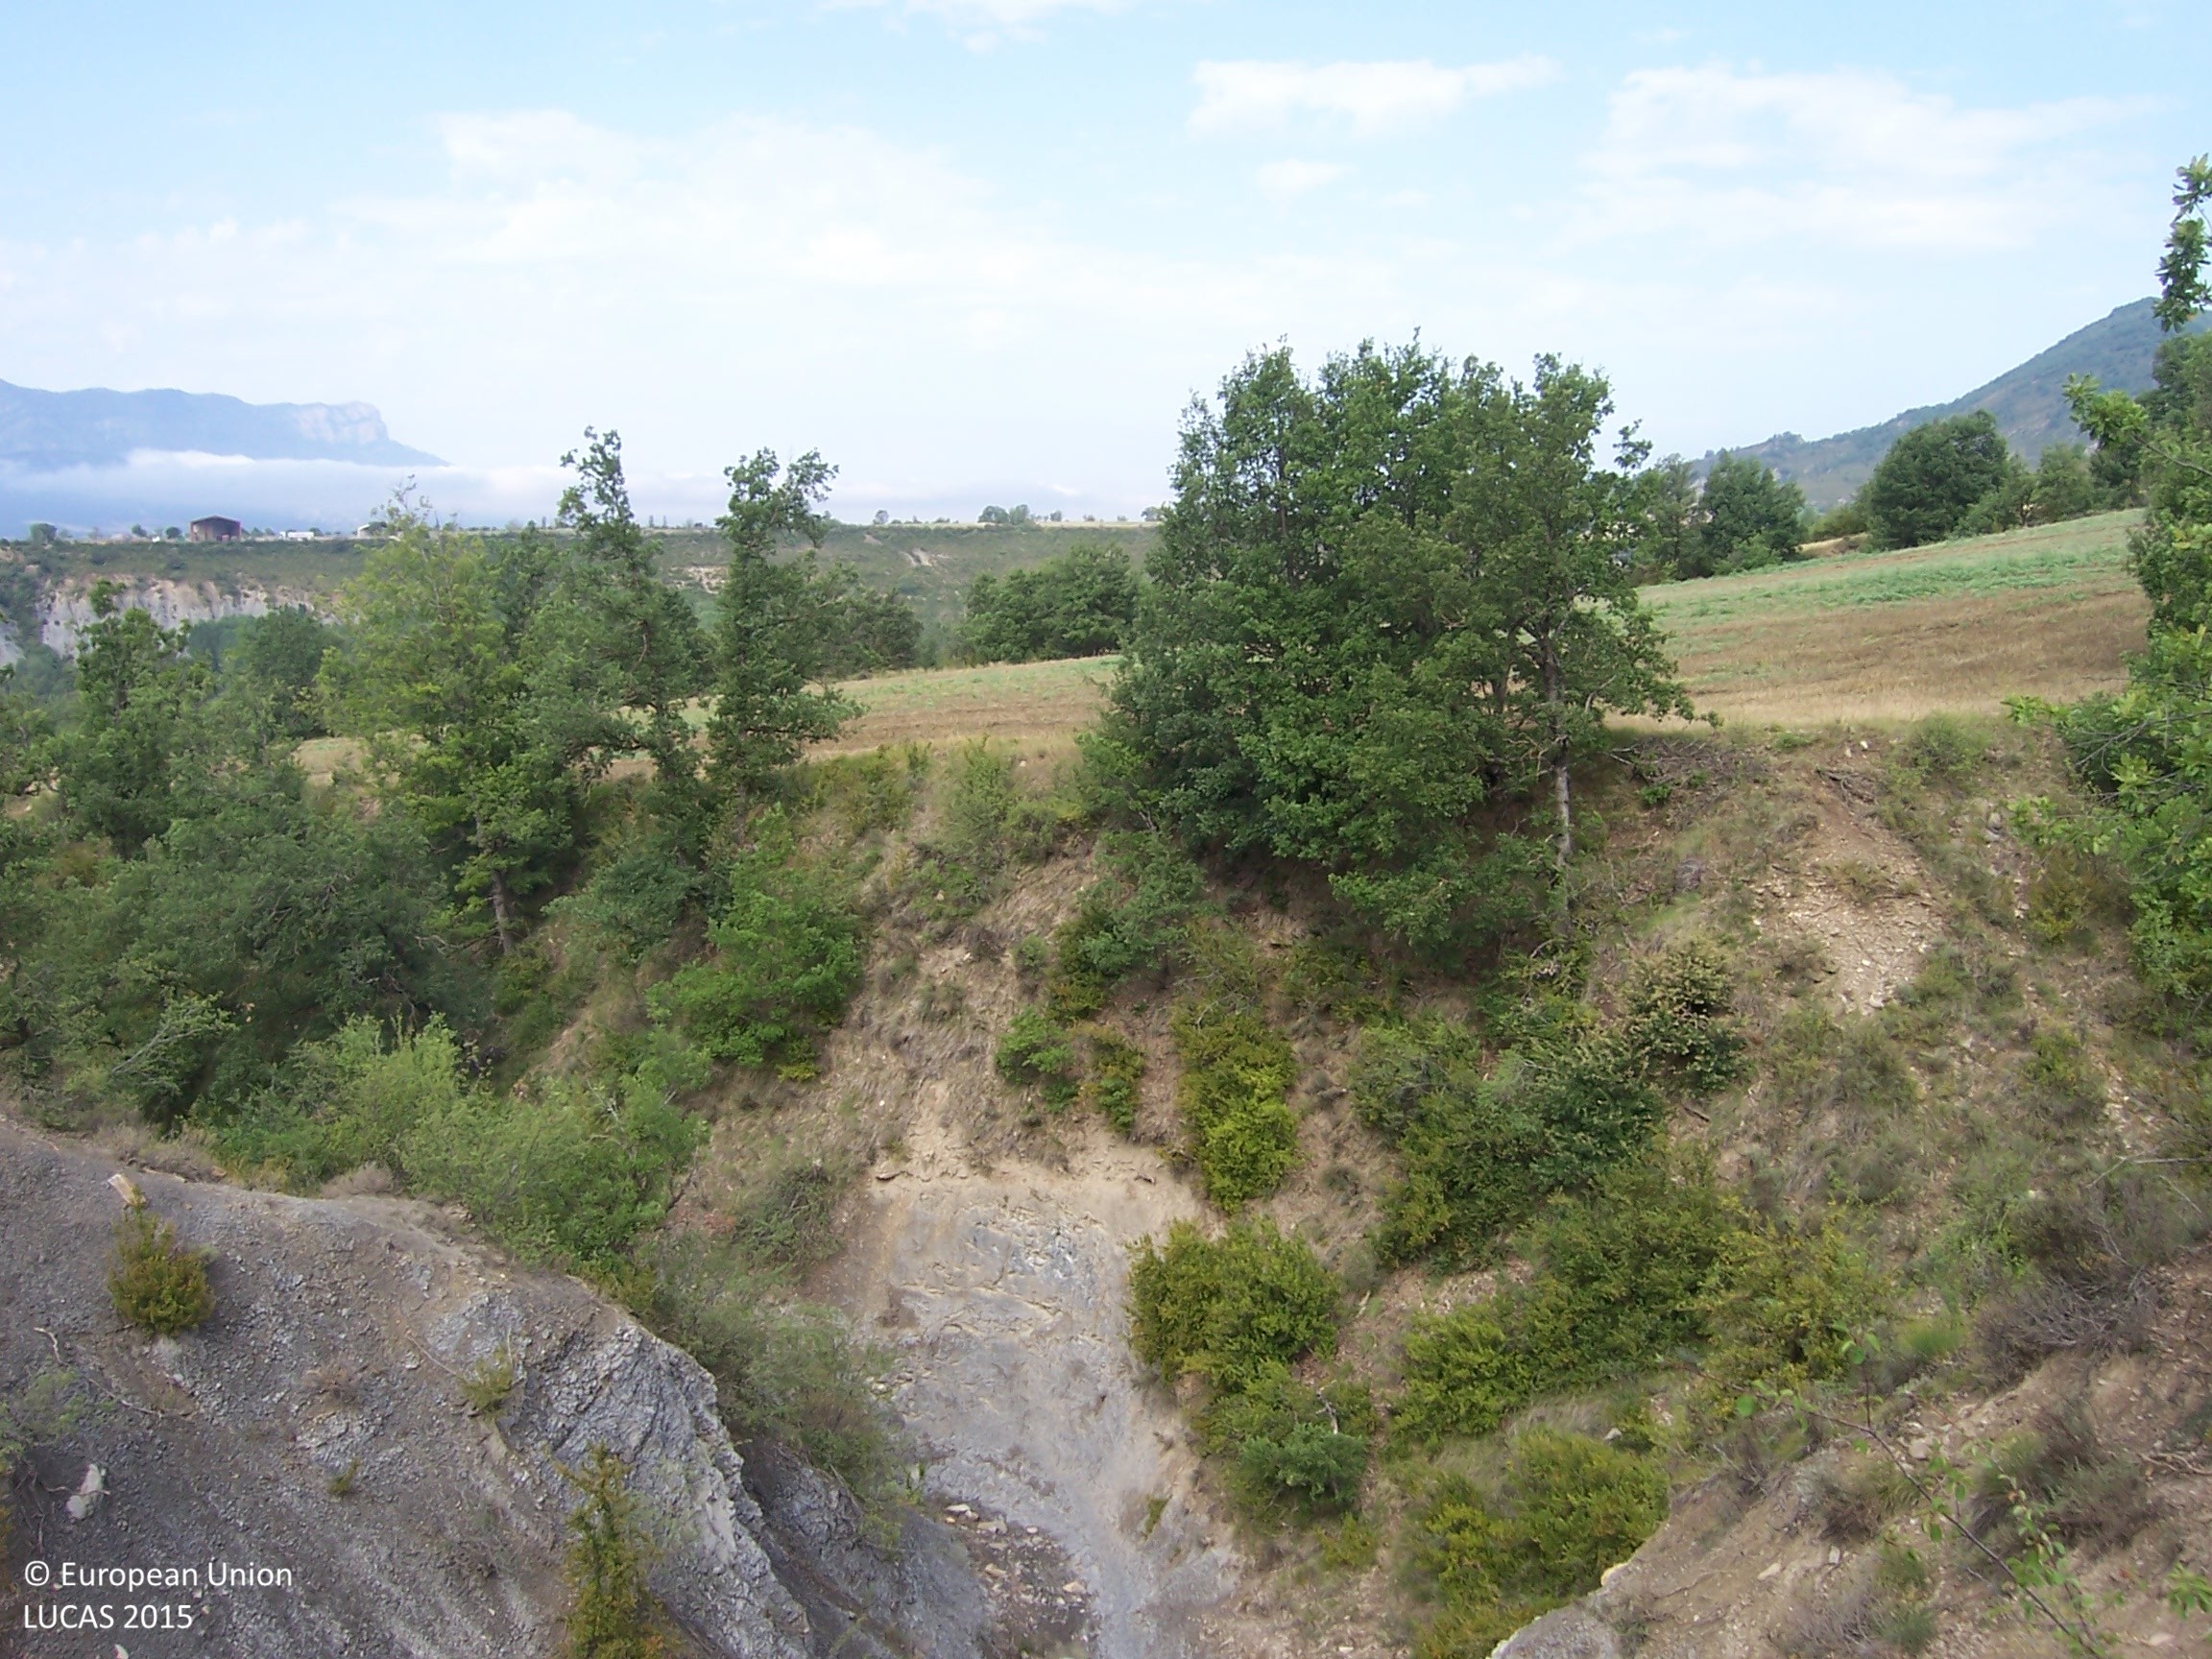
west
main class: Woodland
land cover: Broadleaved woodland
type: acidophilous oak and oak-birch forest
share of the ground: > 75 %
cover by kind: consolidated bare surface 60 %, broadleaved forest trees 30 %, shrubs 10 %
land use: Semi-natural and natural areas not in use
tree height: > 5 m
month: August
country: ES
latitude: 42.5573
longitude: -0.3662
